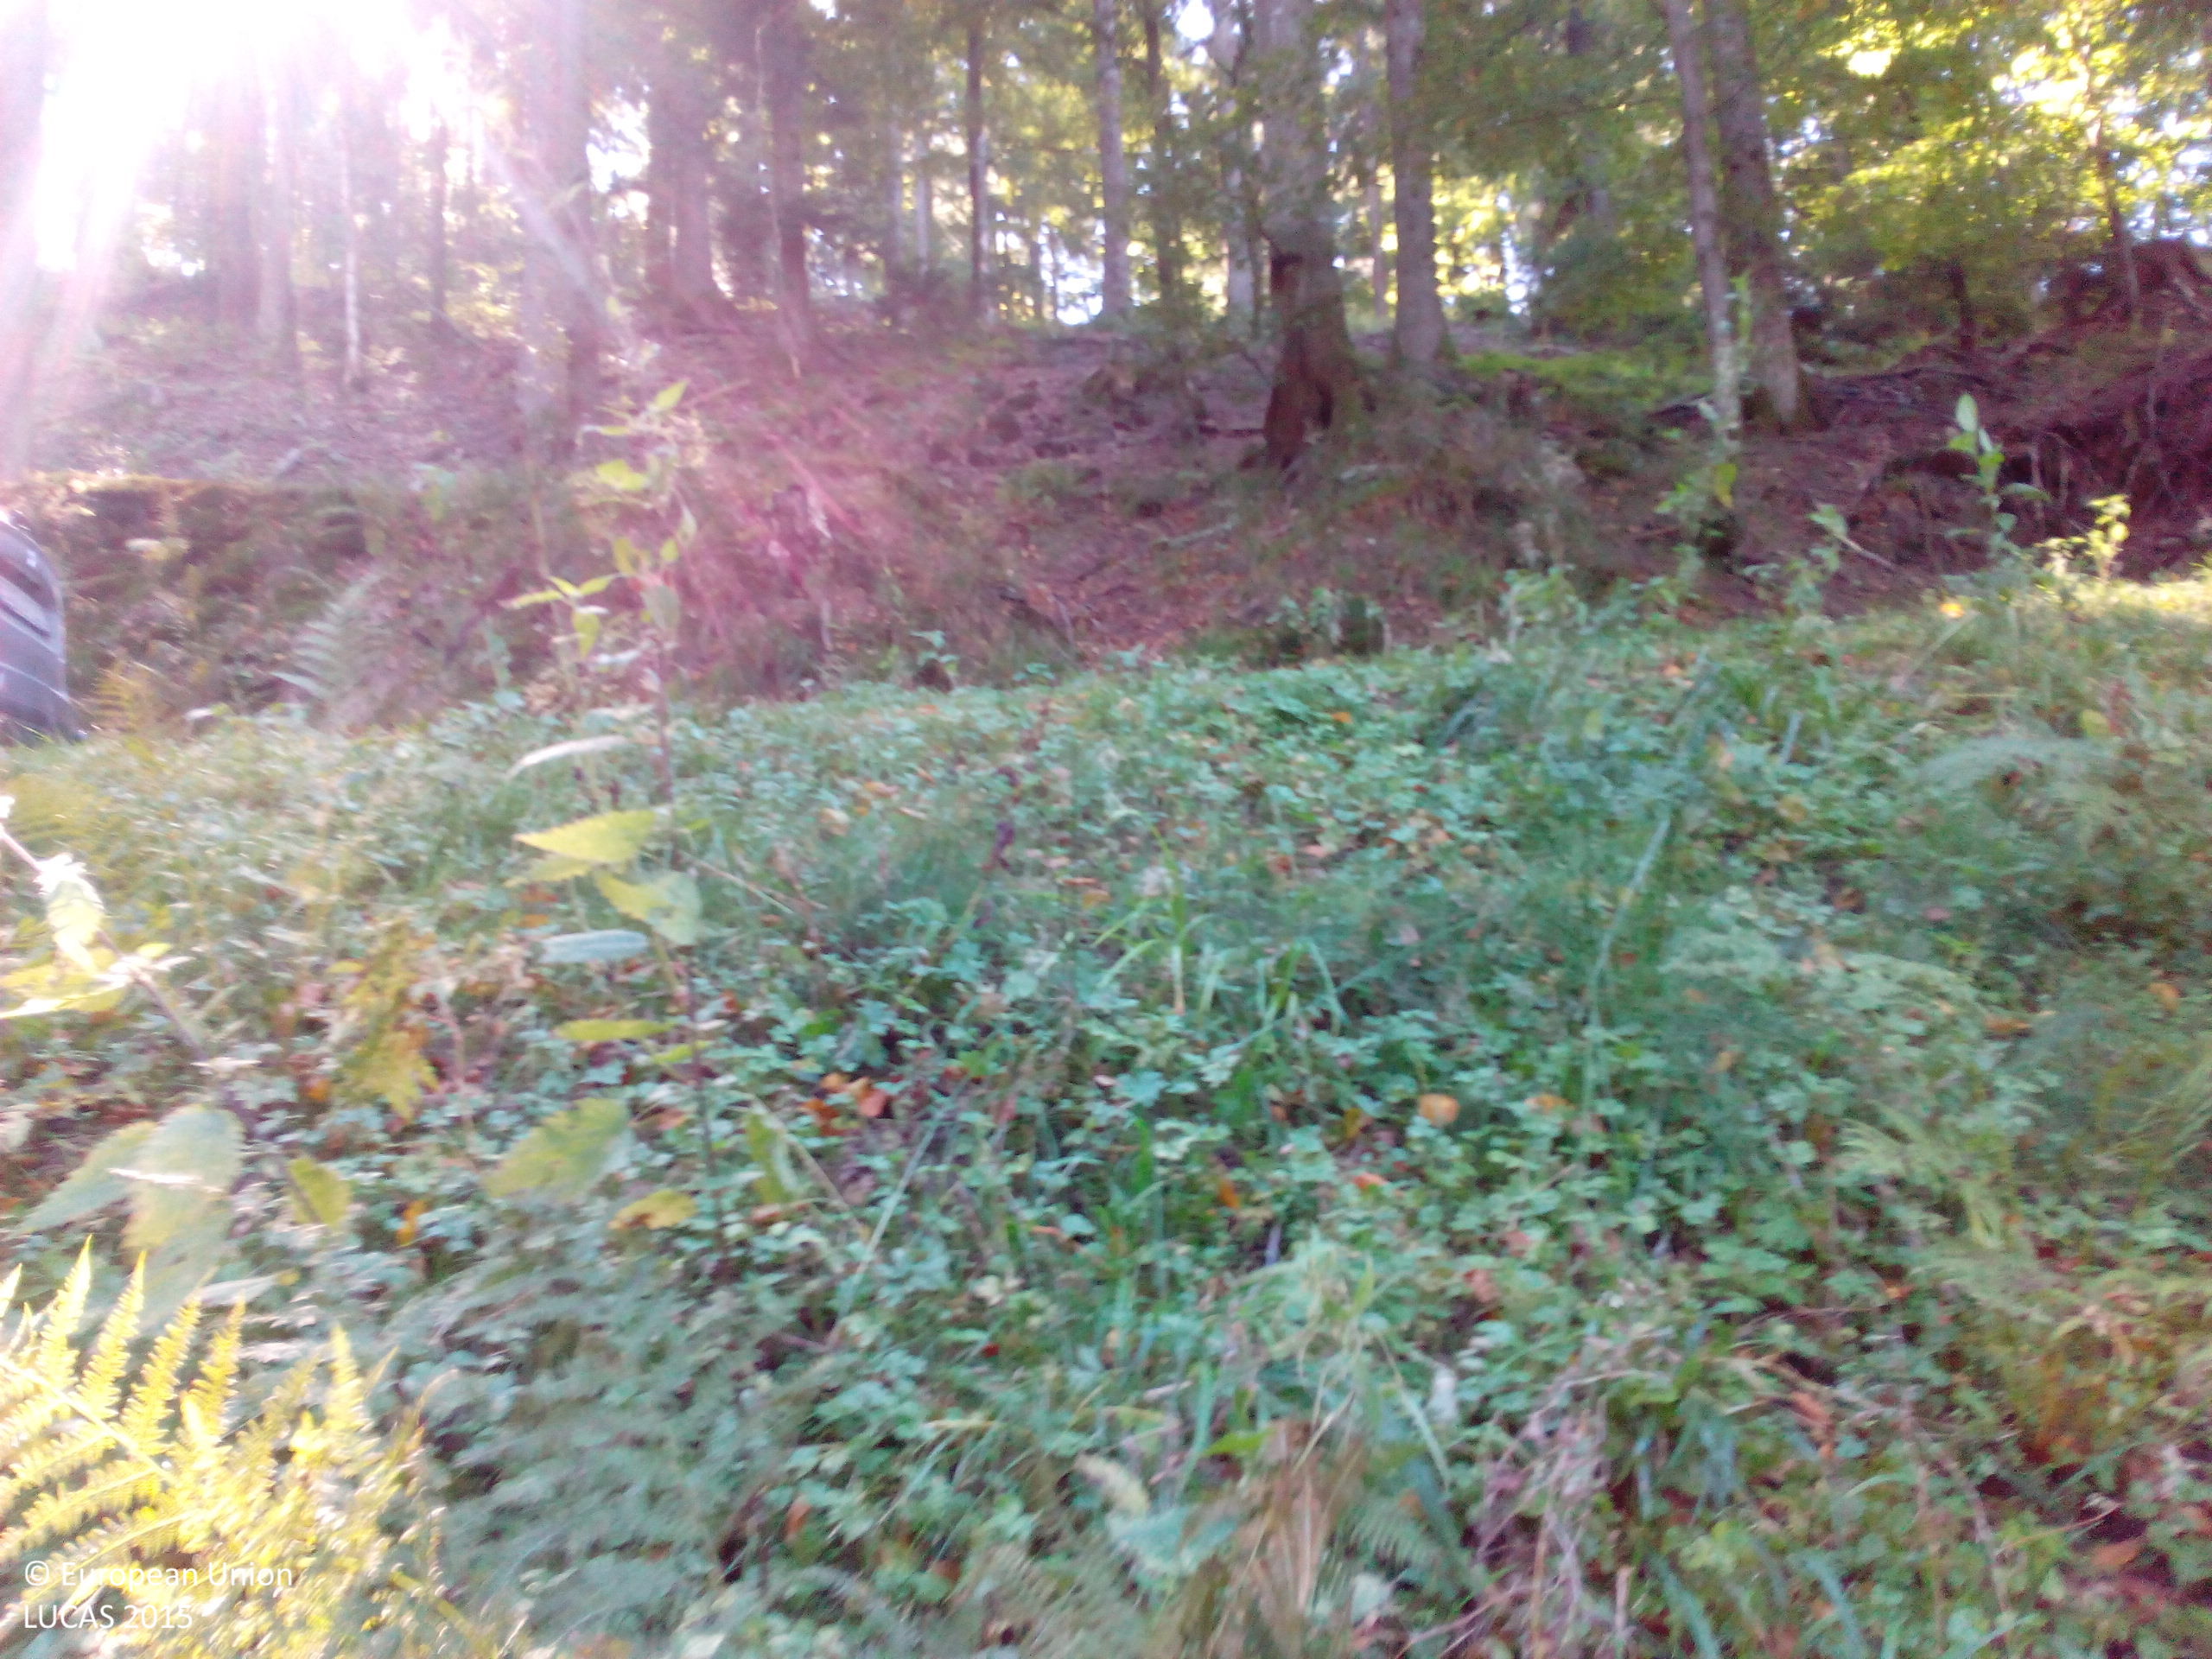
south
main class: Woodland
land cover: Other mixed woodland
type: hemiboreal forest and nemoral coniferous forest and mixed broadleaved-coniferous forest
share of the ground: 50 - 75 %
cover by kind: broadleaved forest trees 40 %, coniferous forest trees 30 %, shrubs 20 %, herbaceous plants 10 %
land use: Forestry
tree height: > 5 m
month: September
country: DE
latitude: 48.6228
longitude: 8.1964
